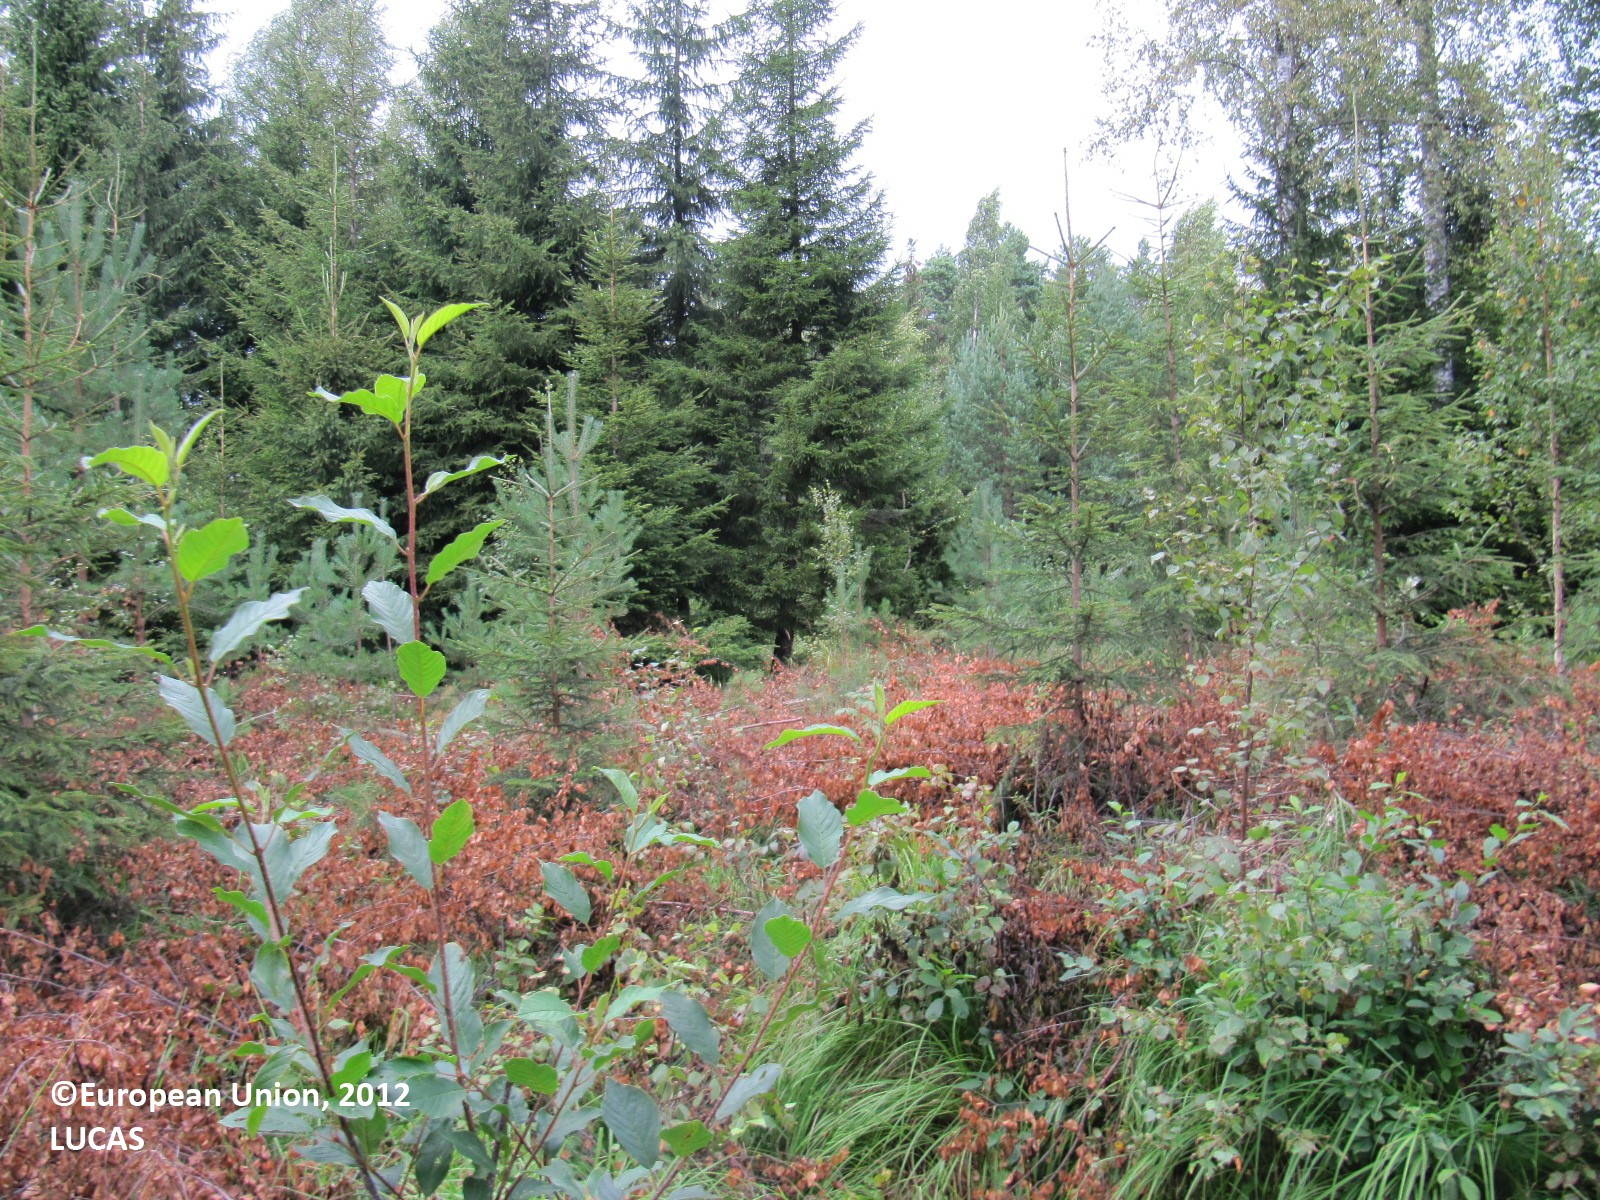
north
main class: Woodland
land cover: Pine dominated mixed woodland
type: boreal forest
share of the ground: > 75 %
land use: Forestry
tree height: > 5 m
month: August
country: FI
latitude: 60.2458
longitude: 23.0691
